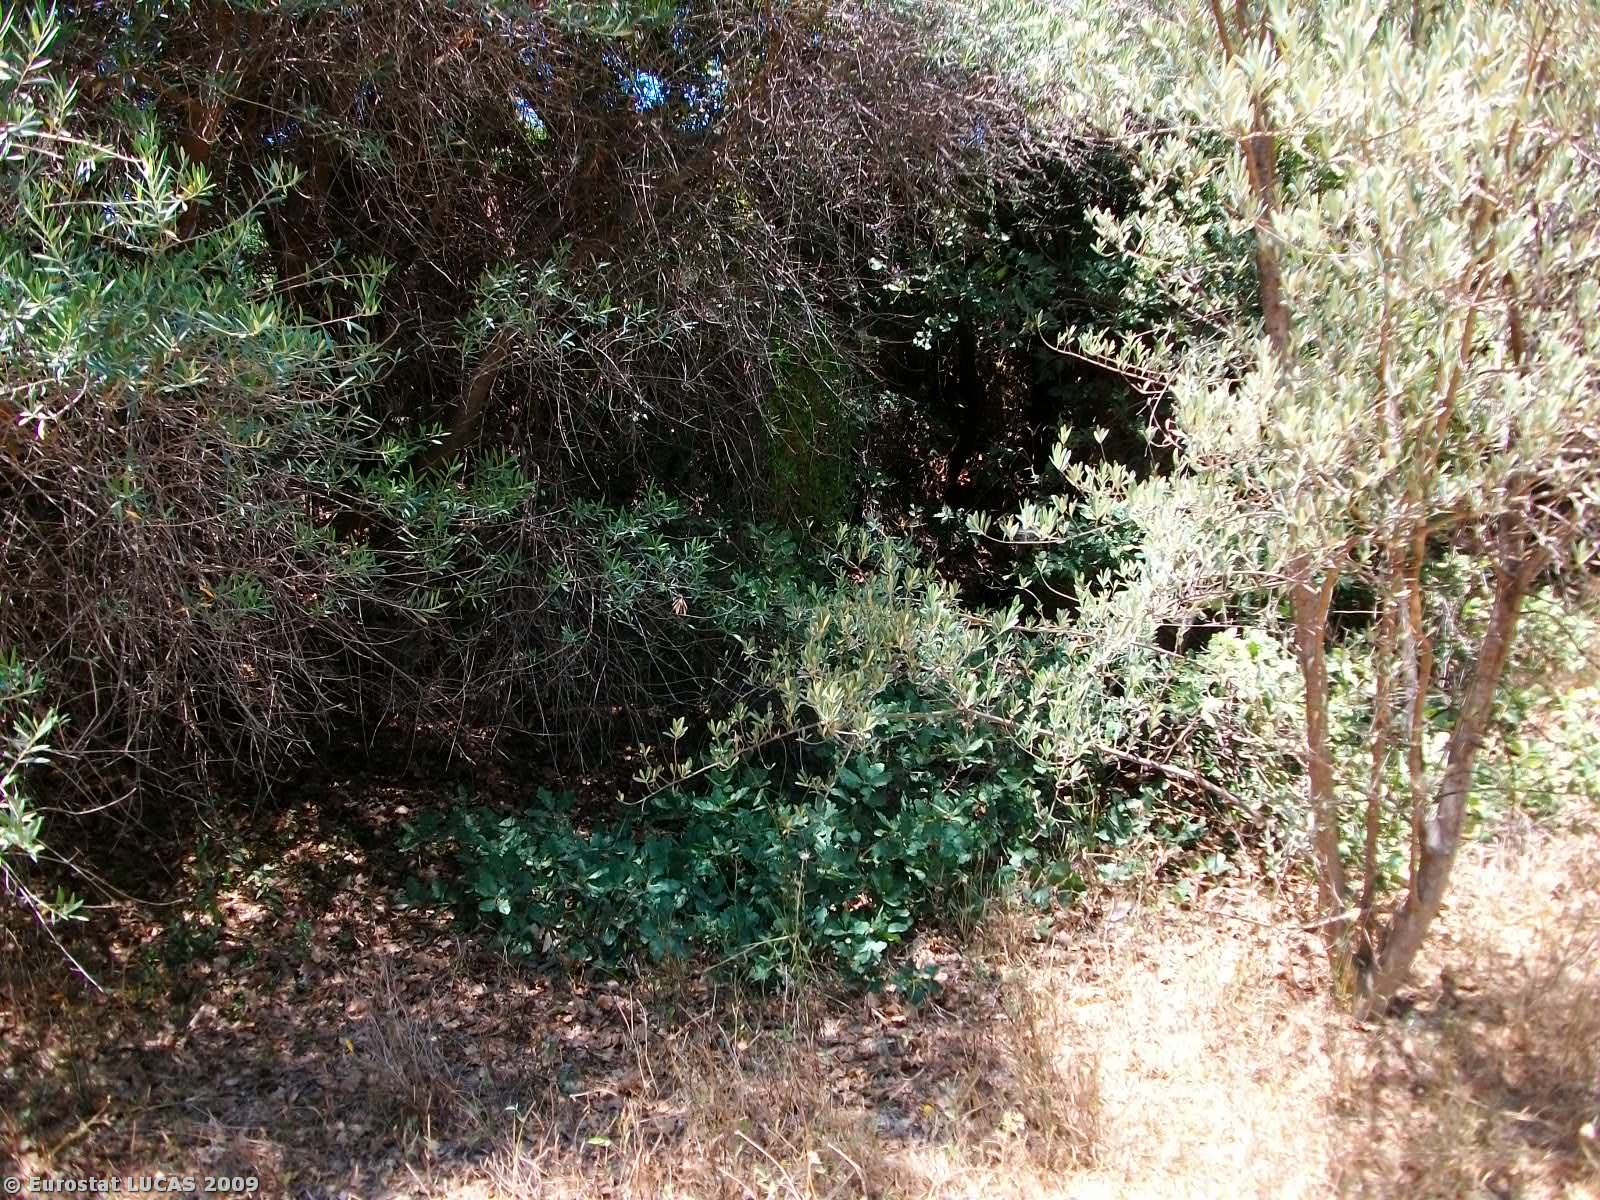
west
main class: Cropland
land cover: Olive groves
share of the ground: 50 - 75 %
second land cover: Bare land
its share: 50 - 75 %
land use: Agriculture (excluding fallow land and kitchen gardens)
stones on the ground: 10 - 25 %
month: May
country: GR
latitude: 35.2438
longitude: 24.9905
